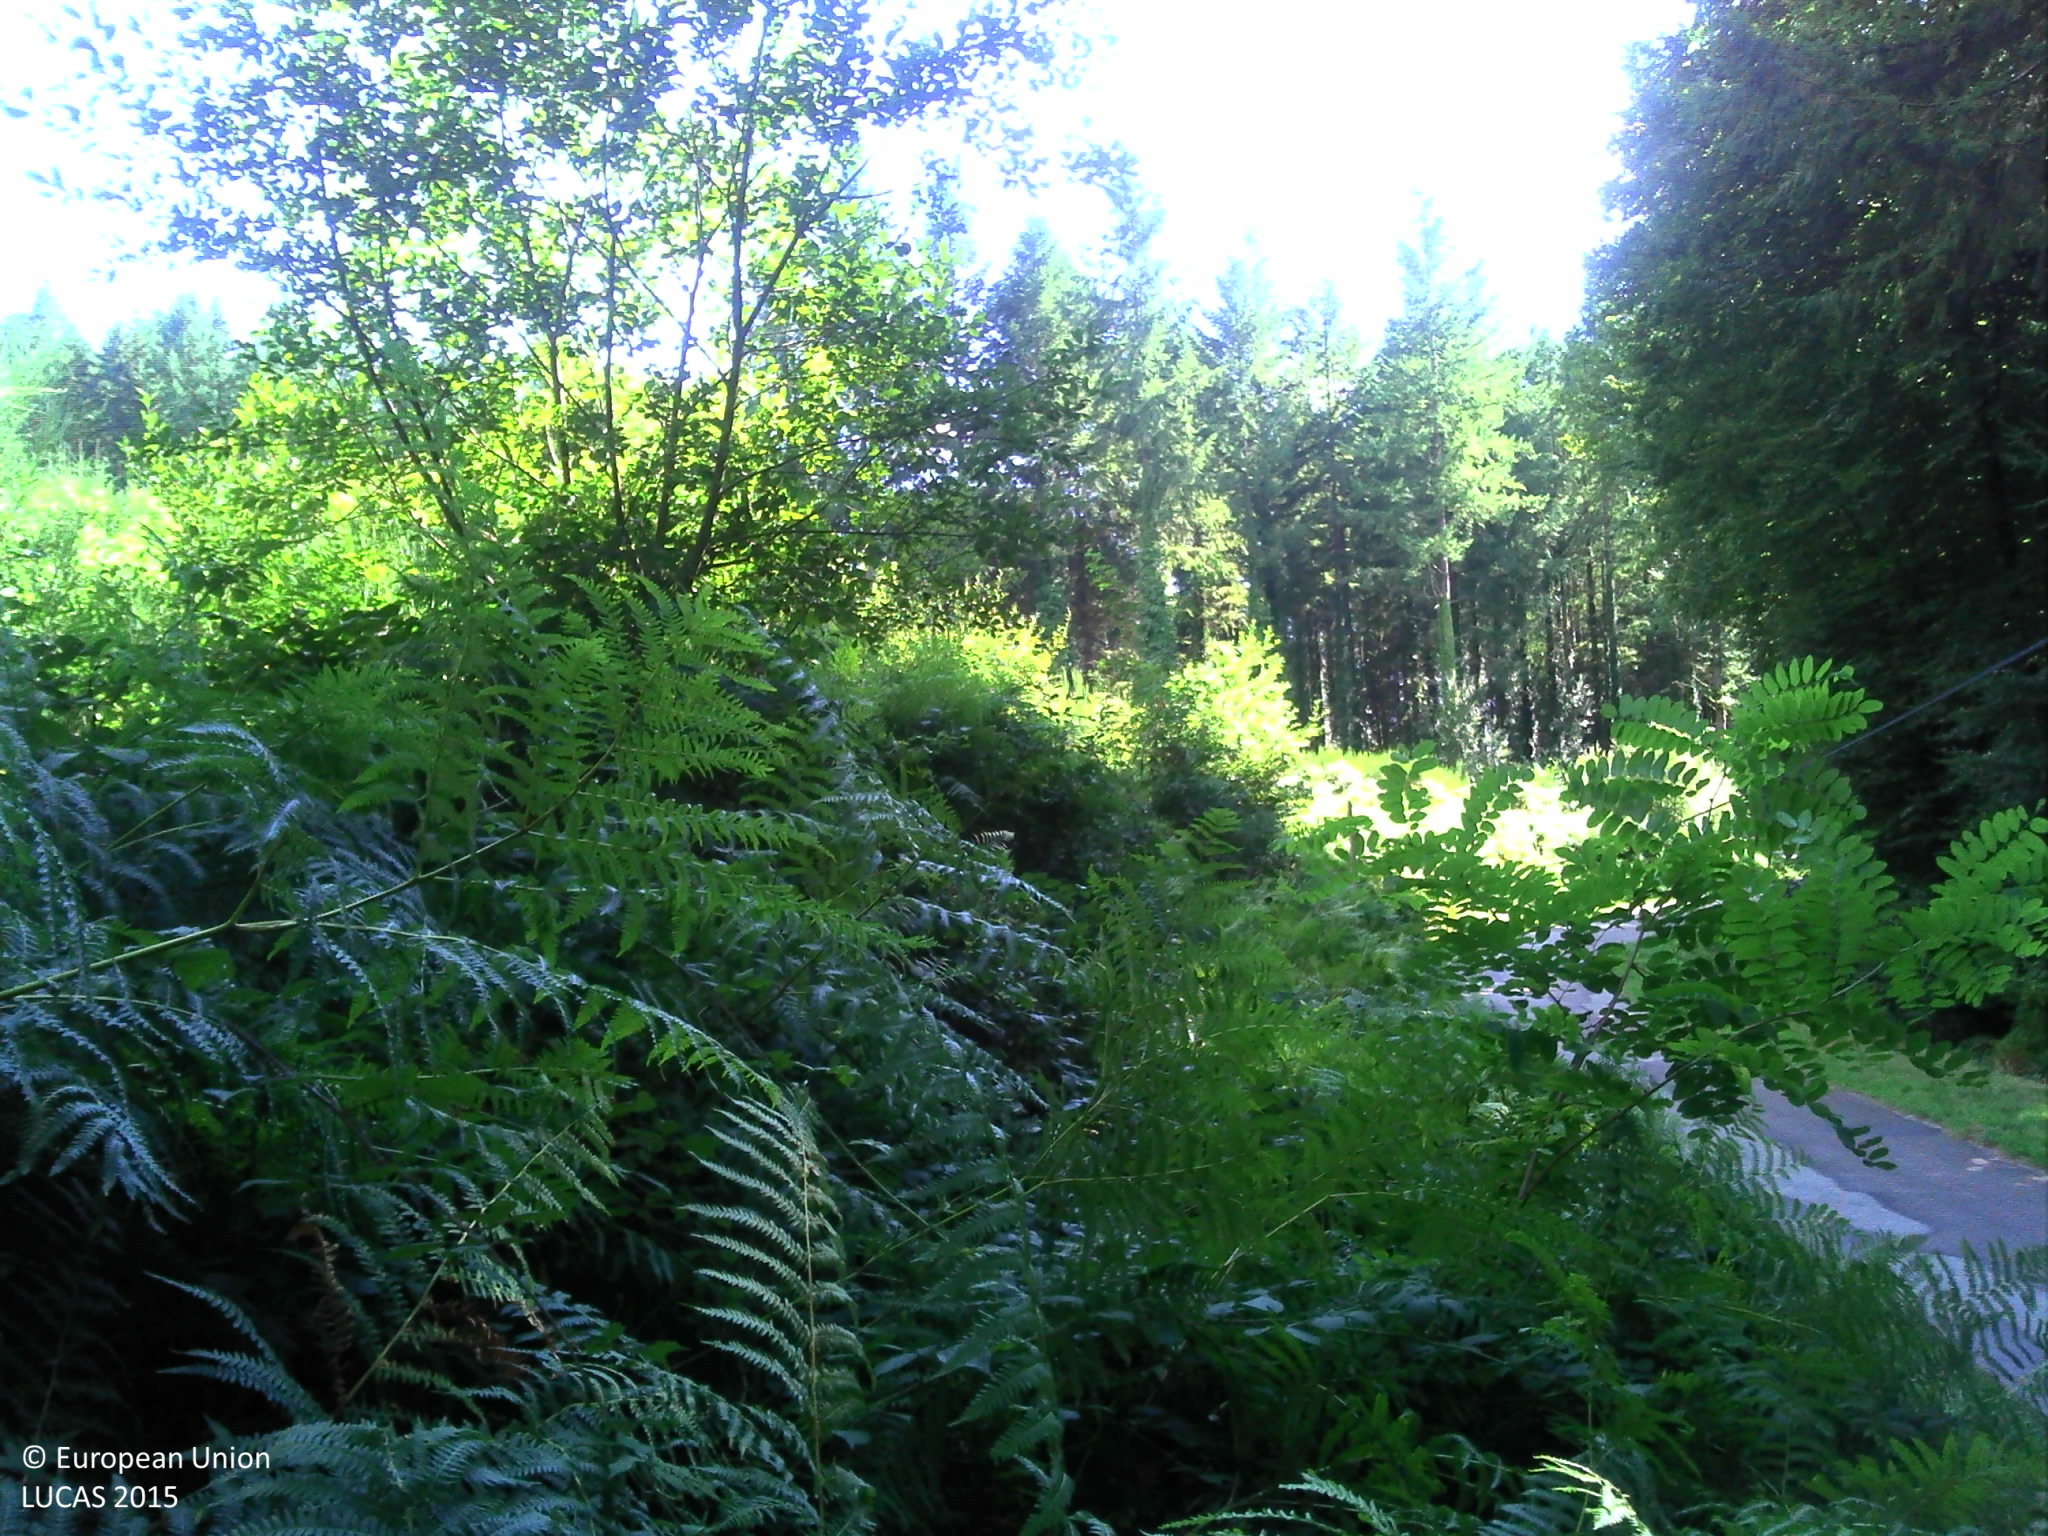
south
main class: Woodland
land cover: Spruce dominated coniferous woodland
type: exotic forest
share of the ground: > 75 %
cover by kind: coniferous forest trees 60 %, shrubs 30 %, broadleaved forest trees 5 %, herbaceous plants 5 %
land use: Forestry
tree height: > 5 m
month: August
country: FR
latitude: 45.8562
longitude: 1.8157
